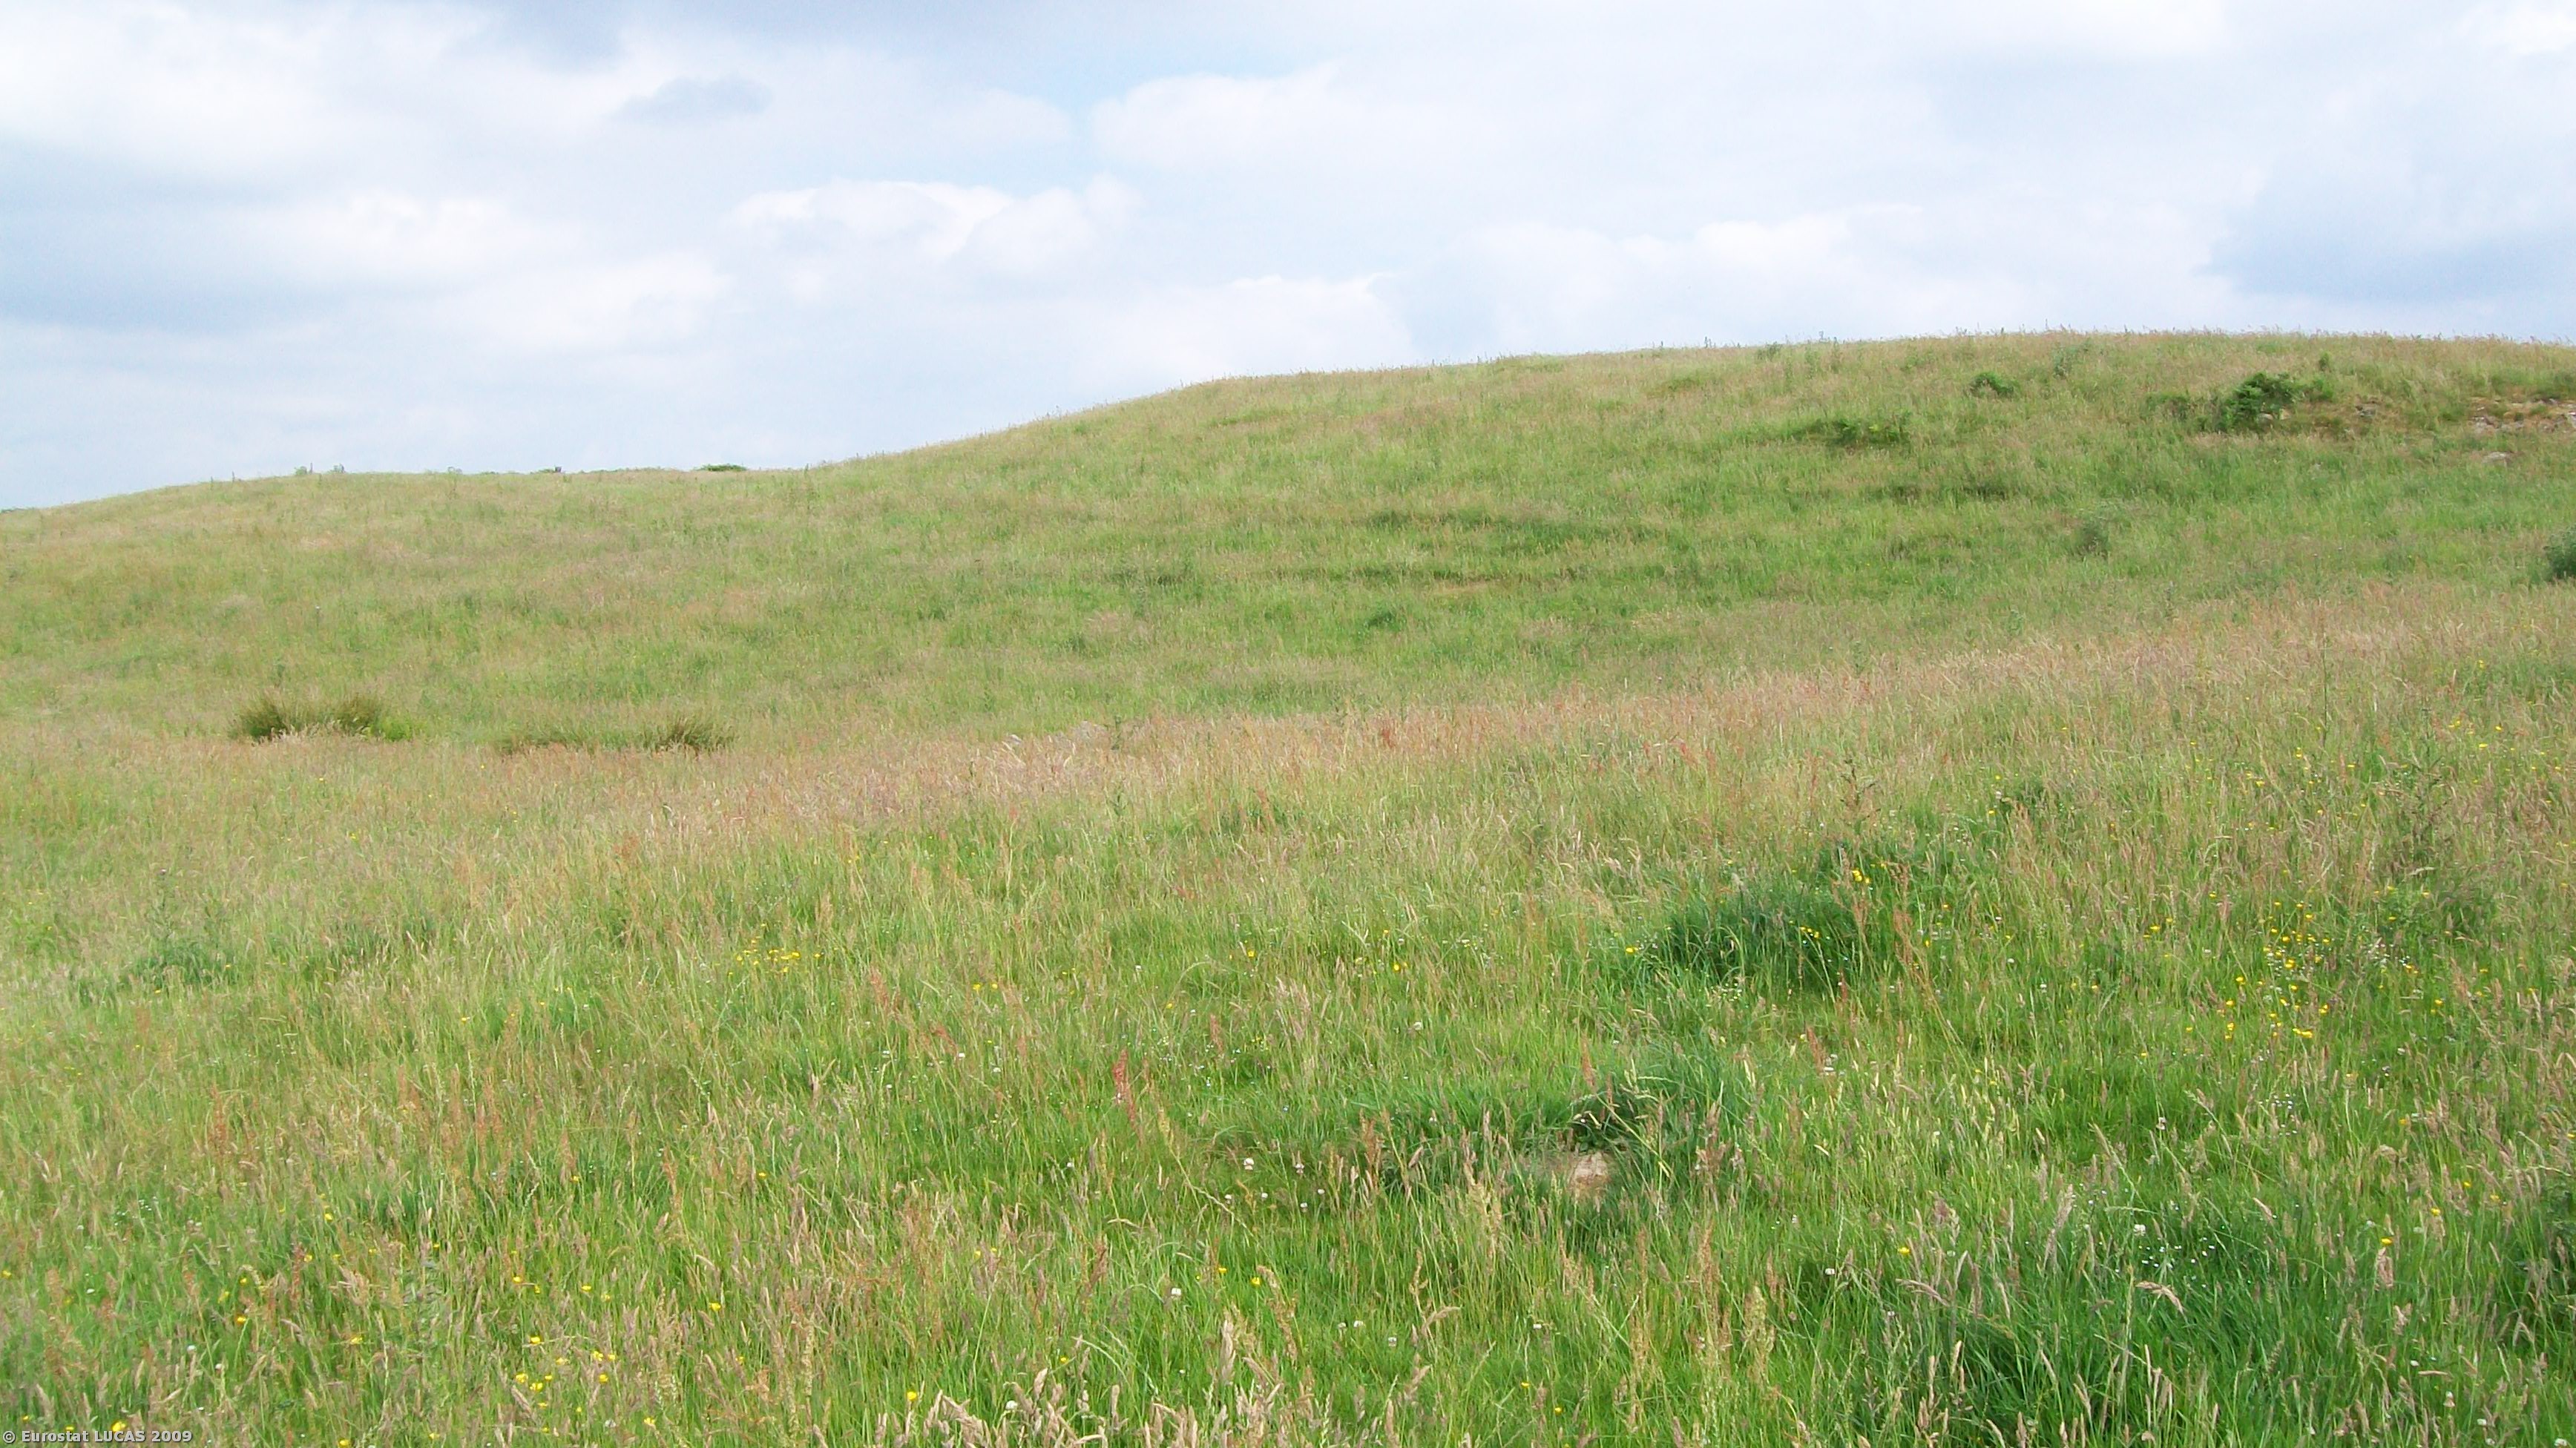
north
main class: Grassland
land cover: Grassland without tree/shrub cover
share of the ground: > 75 %
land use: Agriculture (excluding fallow land and kitchen gardens)
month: July
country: GB
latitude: 54.9856
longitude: -4.0790
